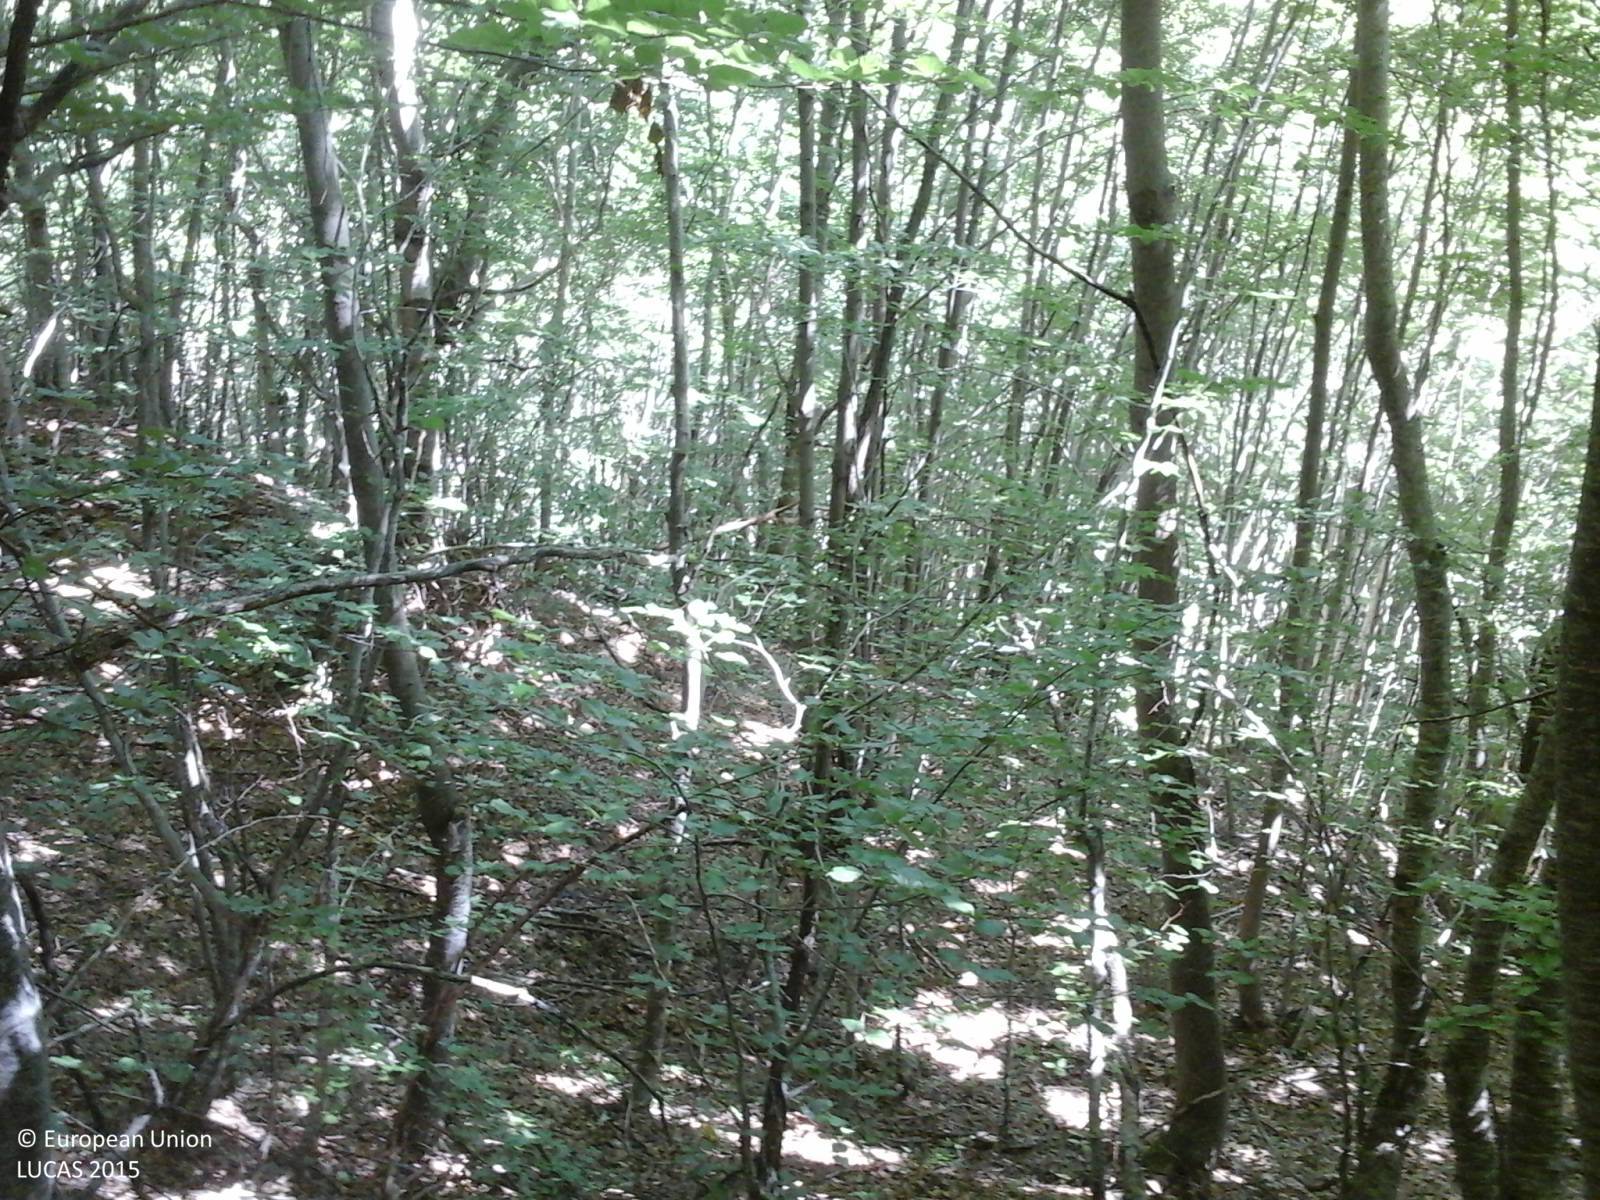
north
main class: Woodland
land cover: Broadleaved woodland
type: mountainous beech forest
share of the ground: > 75 %
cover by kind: broadleaved forest trees 100 %
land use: Semi-natural and natural areas not in use
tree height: > 5 m
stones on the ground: < 10 %
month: July
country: IT
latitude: 42.5243
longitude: 13.4101
